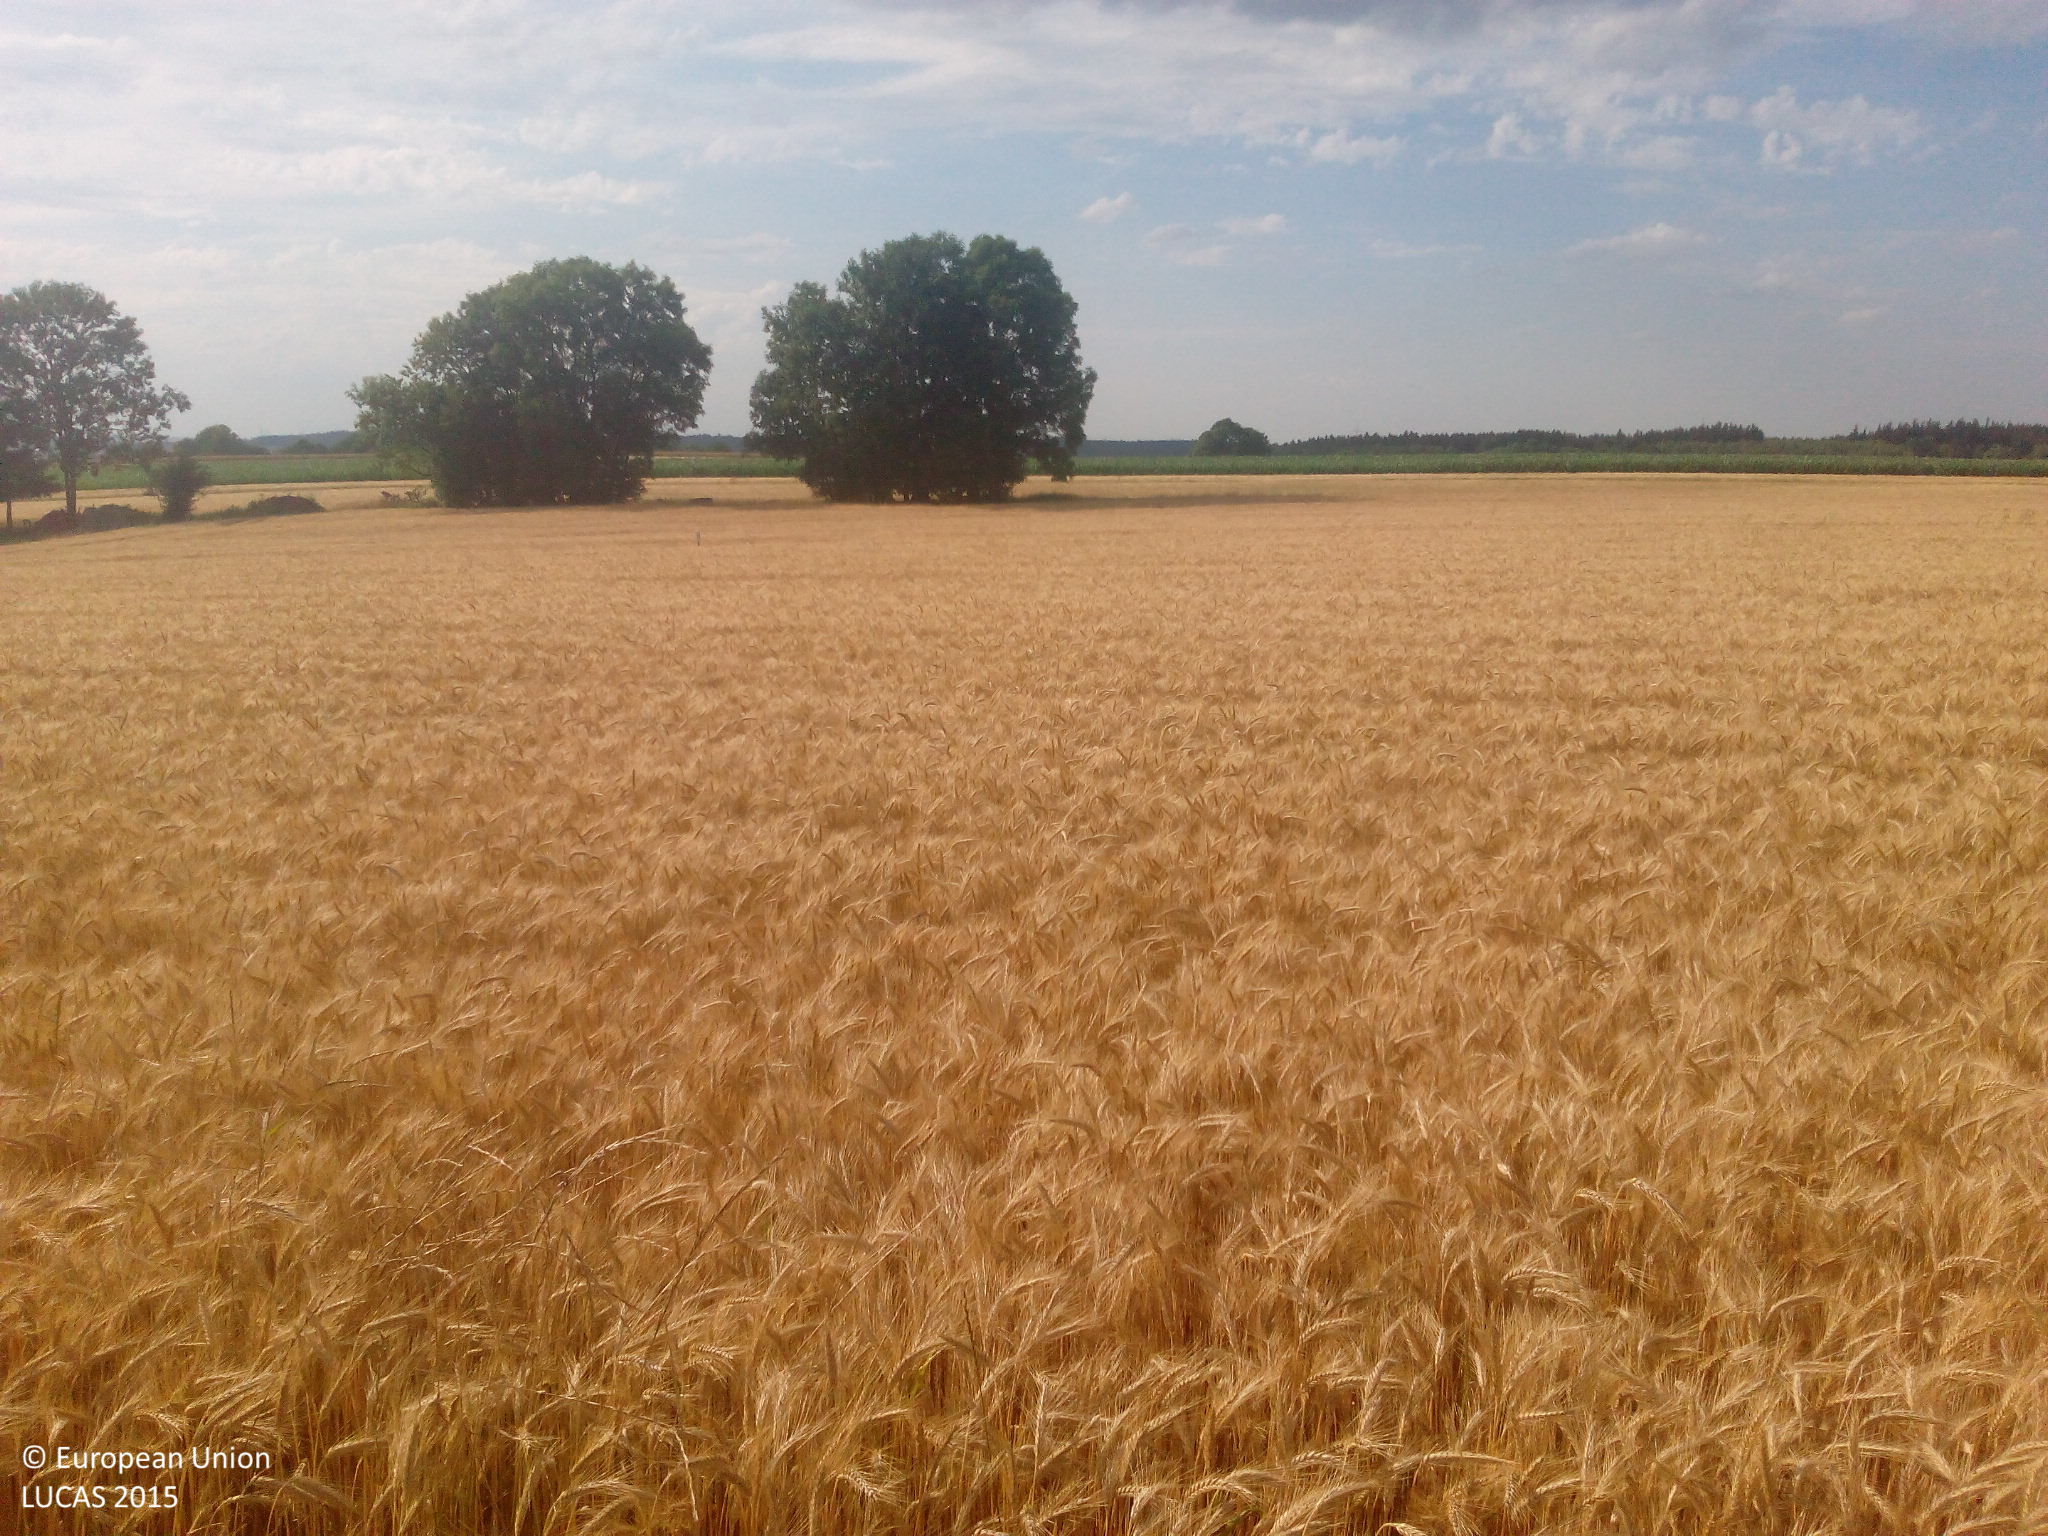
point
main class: Cropland
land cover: Triticale
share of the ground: > 75 %
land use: Agriculture (excluding fallow land and kitchen gardens)
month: July
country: DE
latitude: 50.9040
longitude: 13.5129
